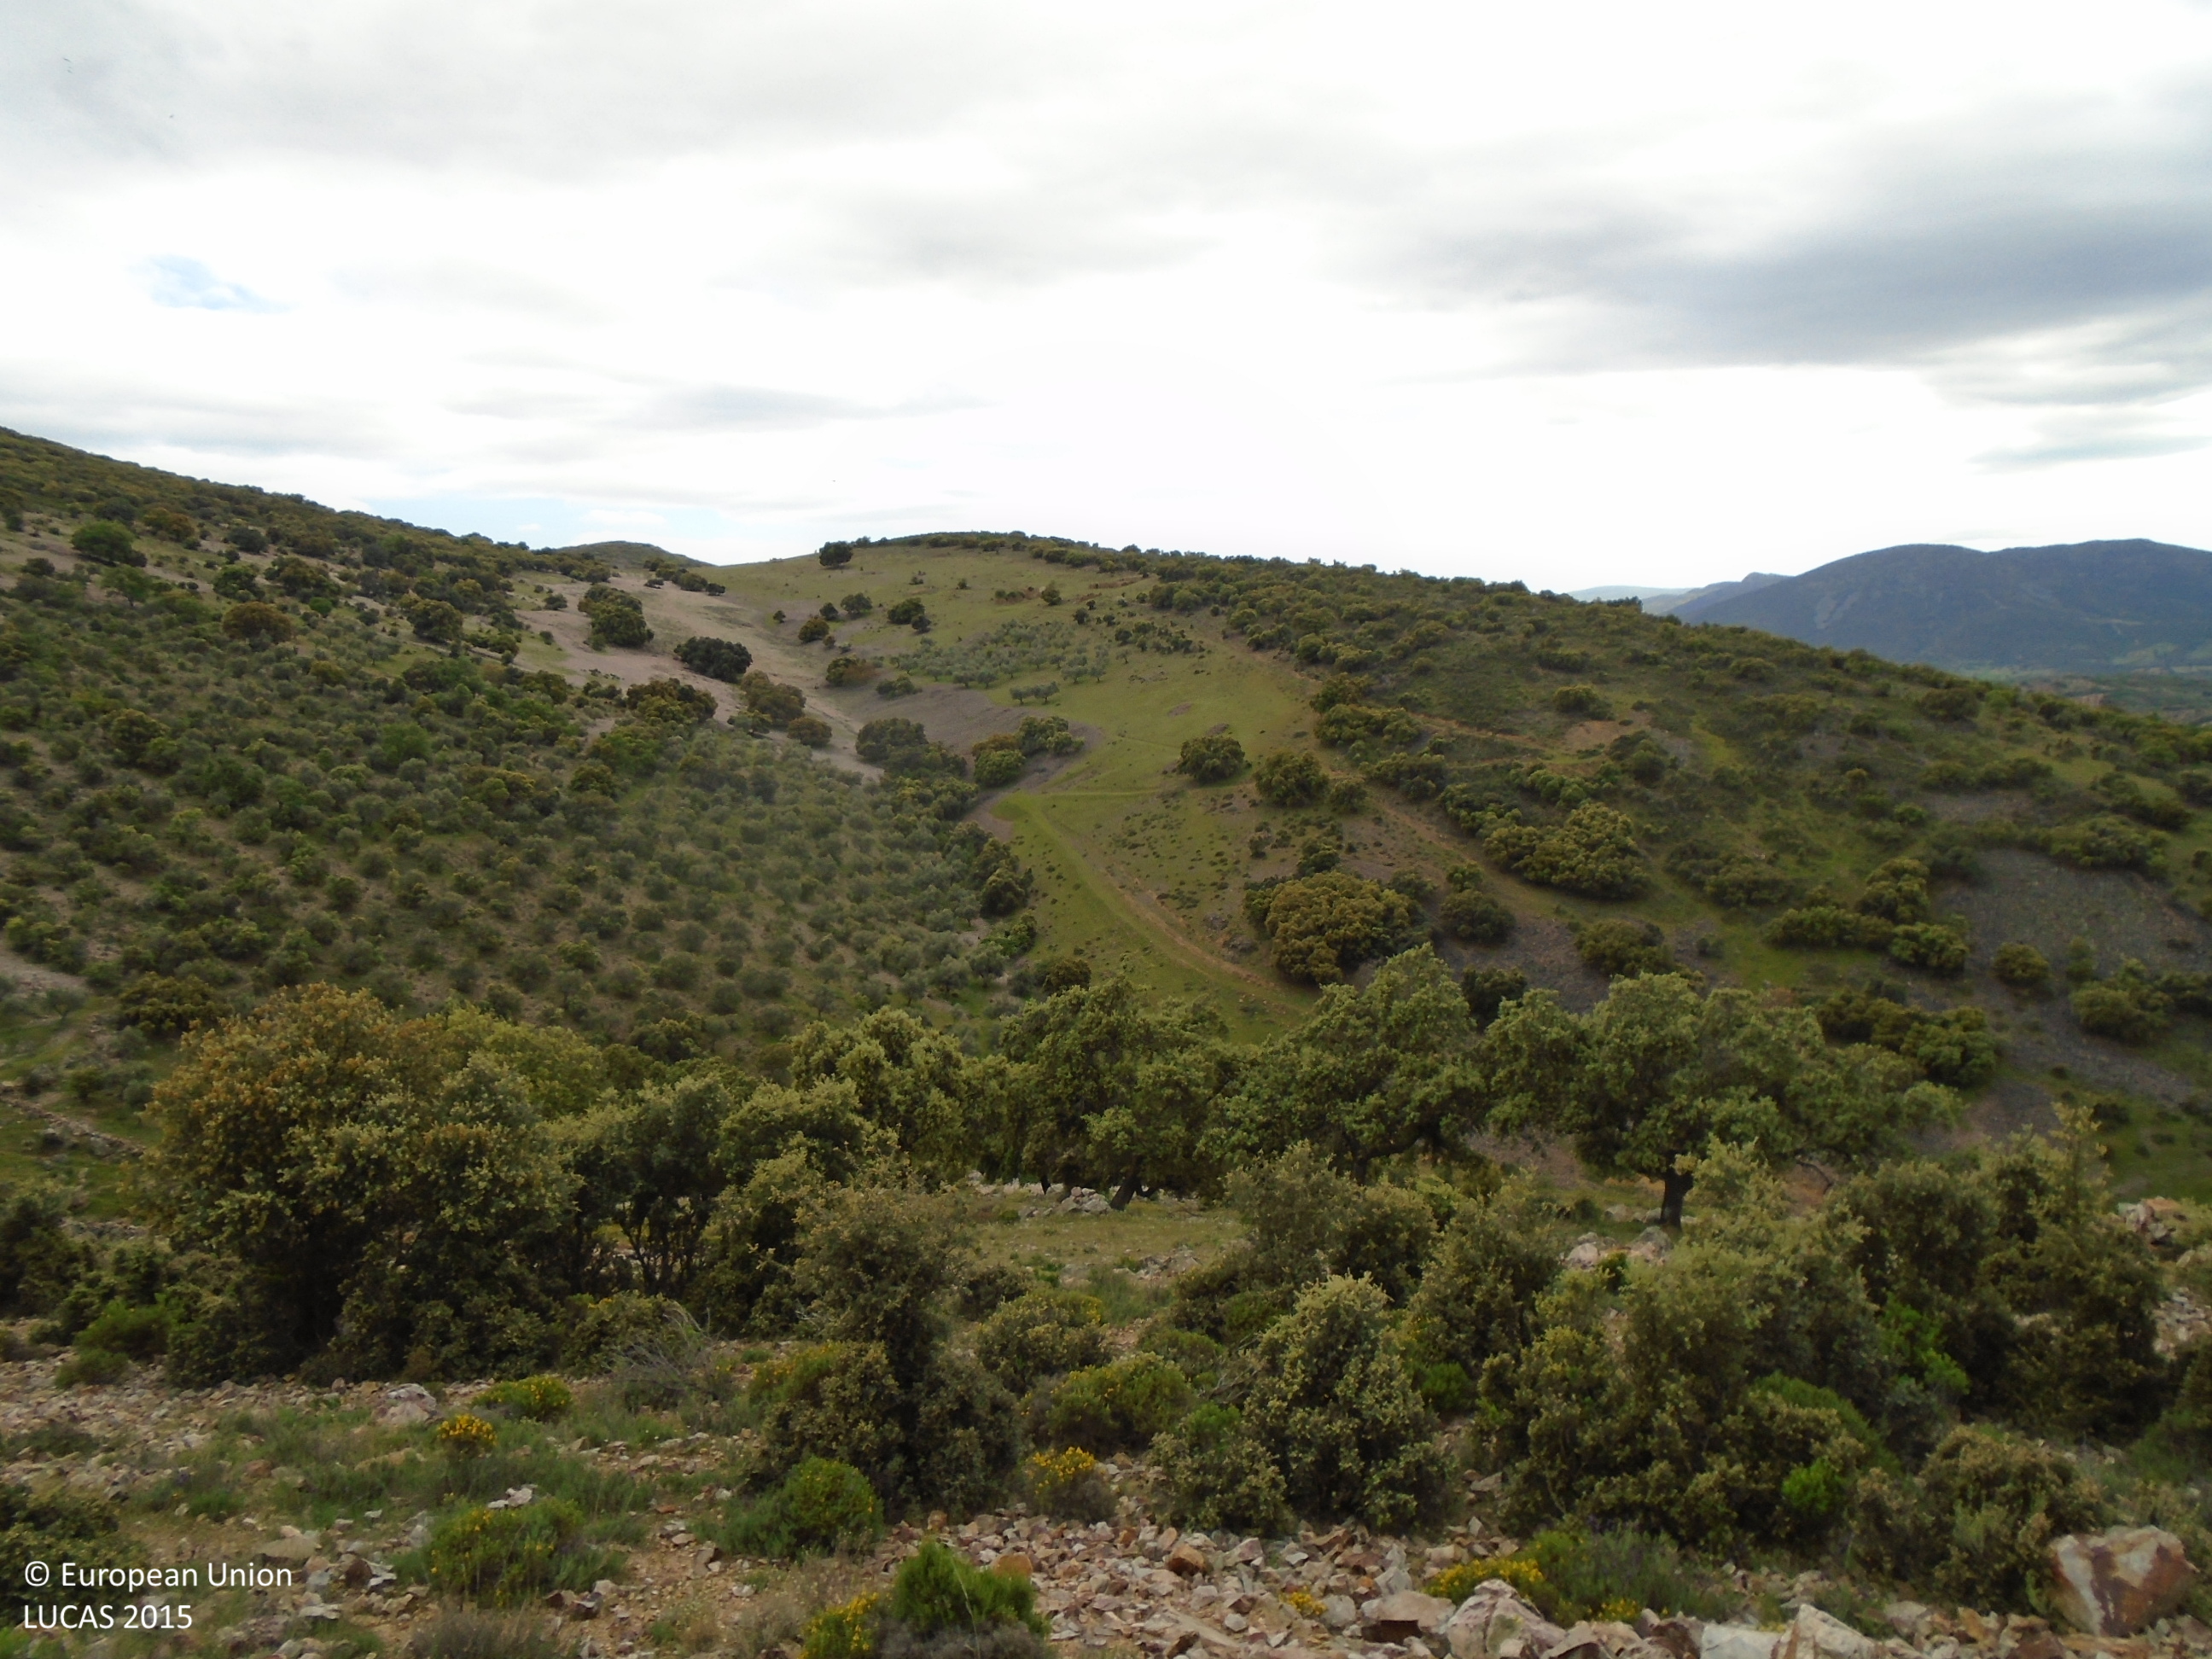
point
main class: Grassland
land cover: Grassland with sparse tree/shrub cover
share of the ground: > 75 %
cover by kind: herbaceous plants 85 %, broadleaved forest trees 5 %, shrubs 5 %, consolidated bare surface 5 %
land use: Semi-natural and natural areas not in use
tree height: < 5 m
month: May
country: ES
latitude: 39.6609
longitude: -4.6215
